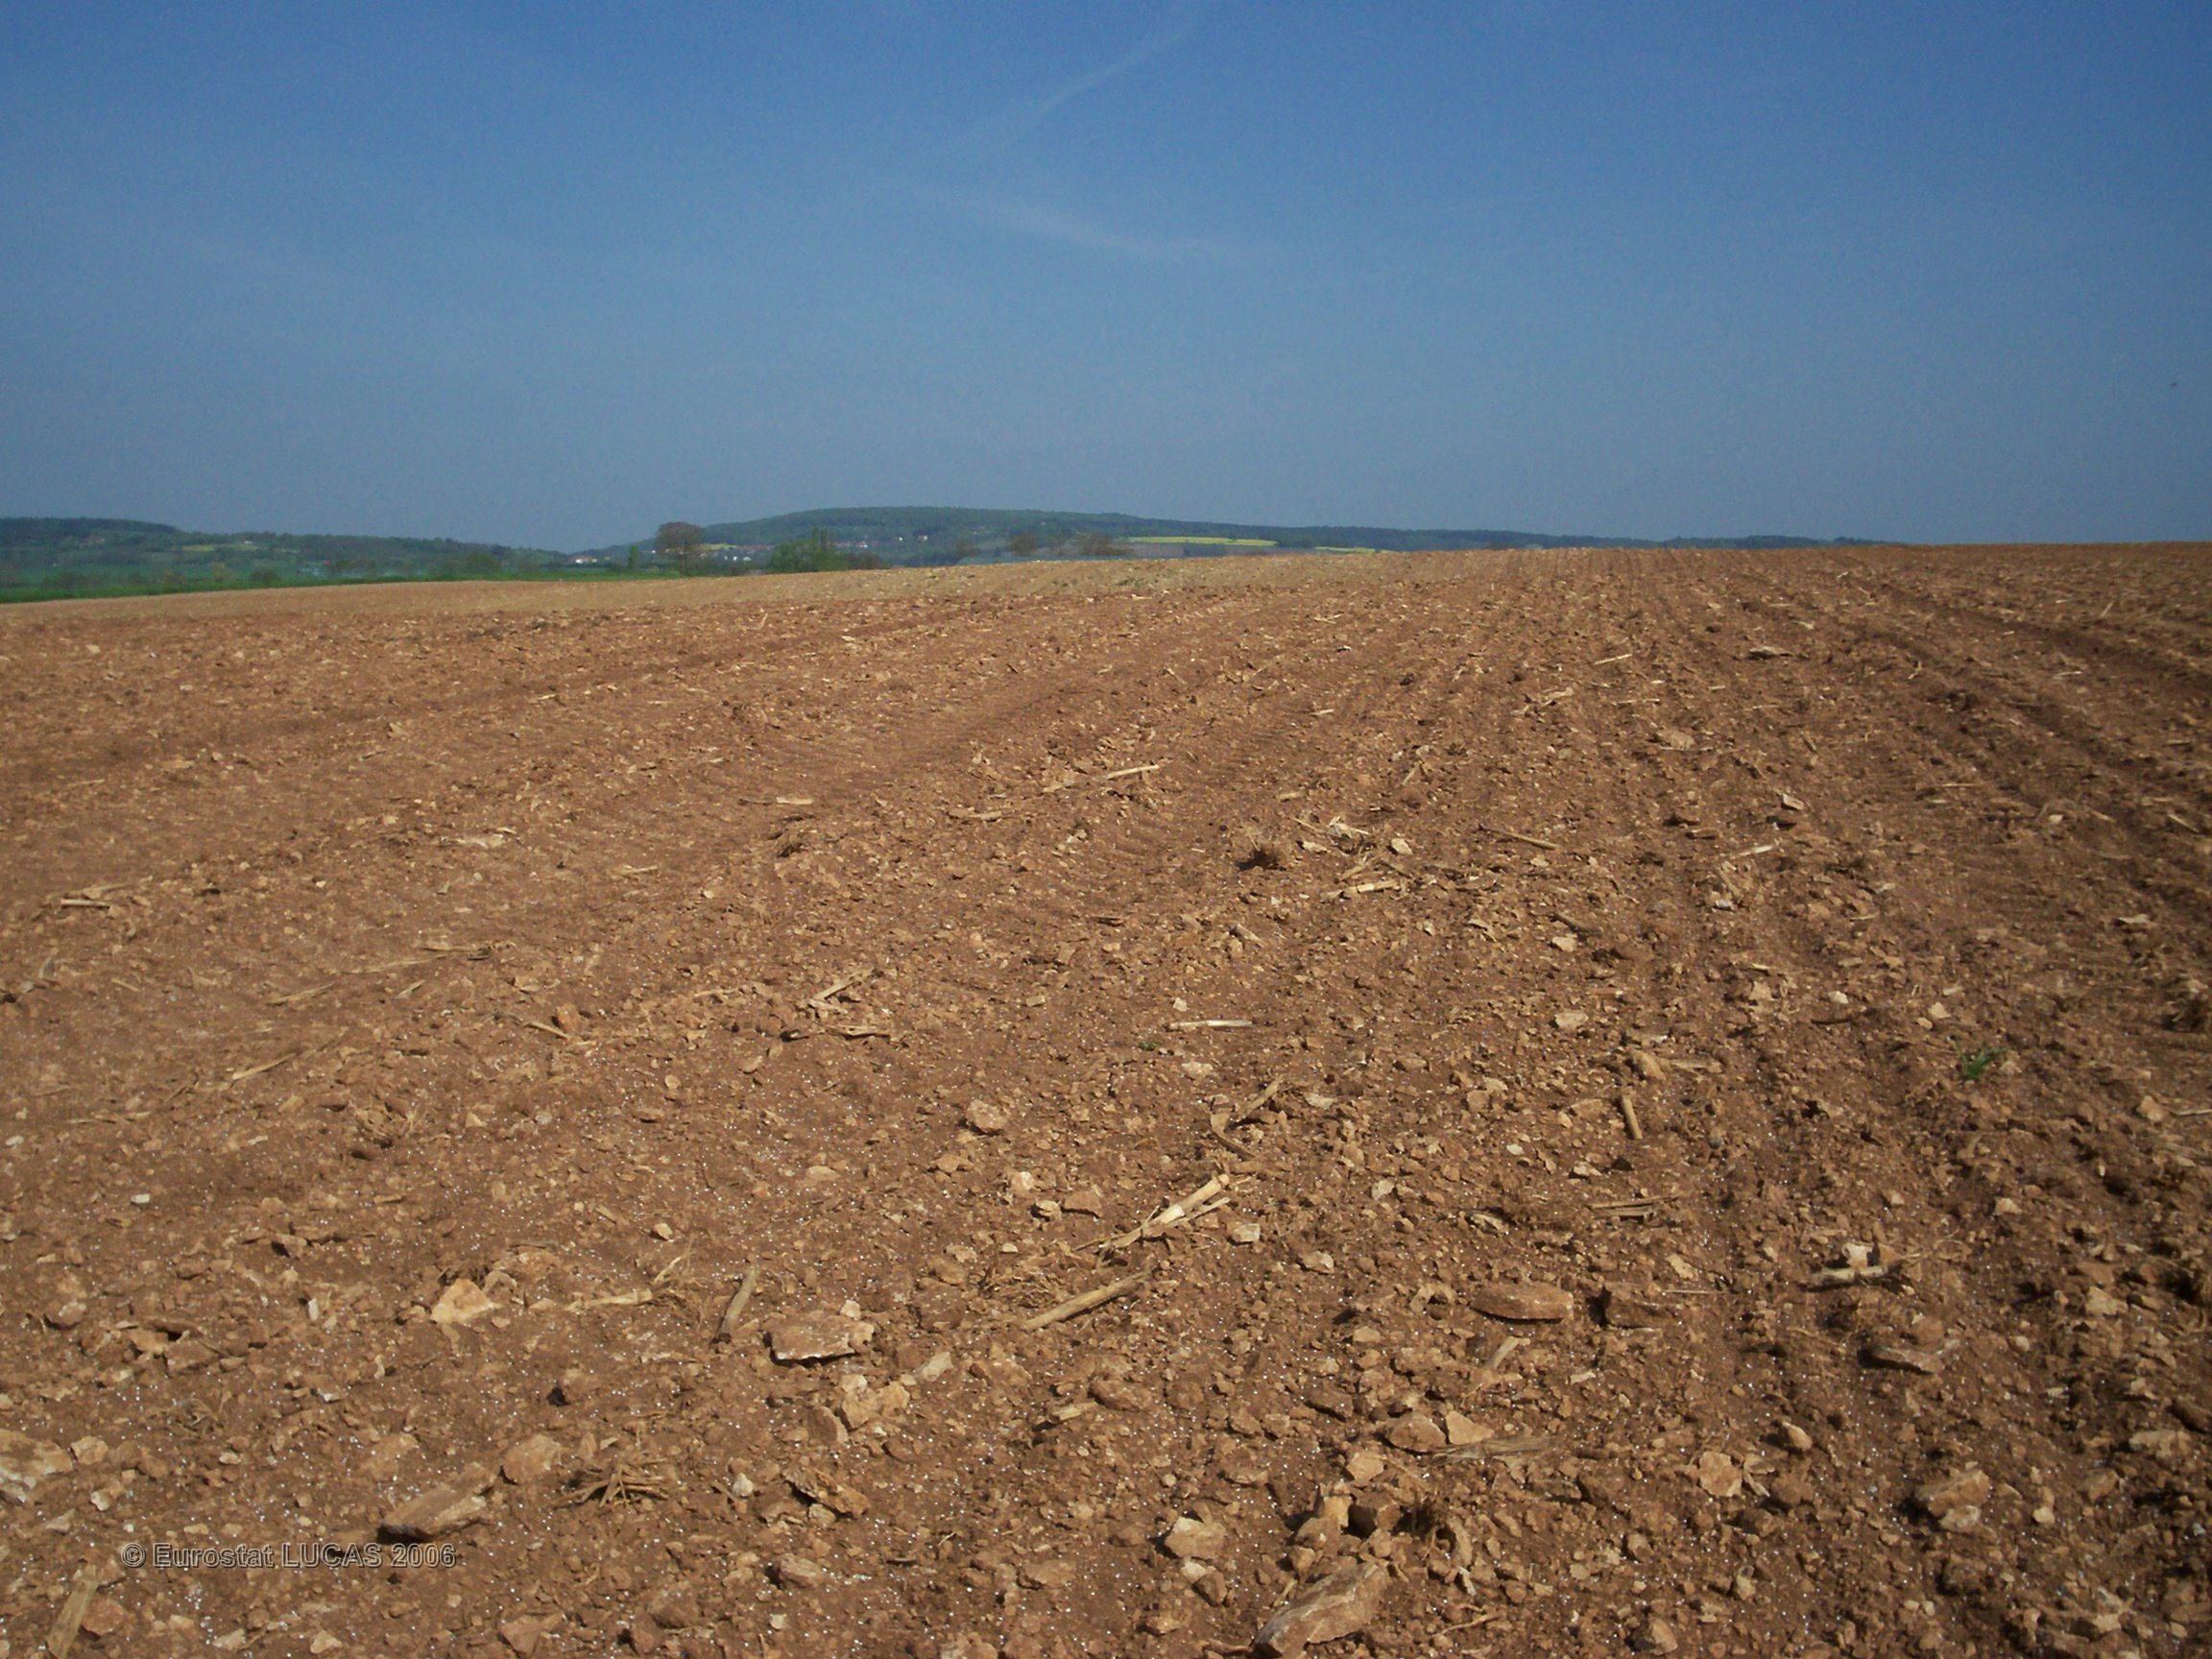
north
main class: Cropland
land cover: Maize
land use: Agriculture (excluding fallow land and kitchen gardens)
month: May
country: FR
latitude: 47.6367
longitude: 5.3020
